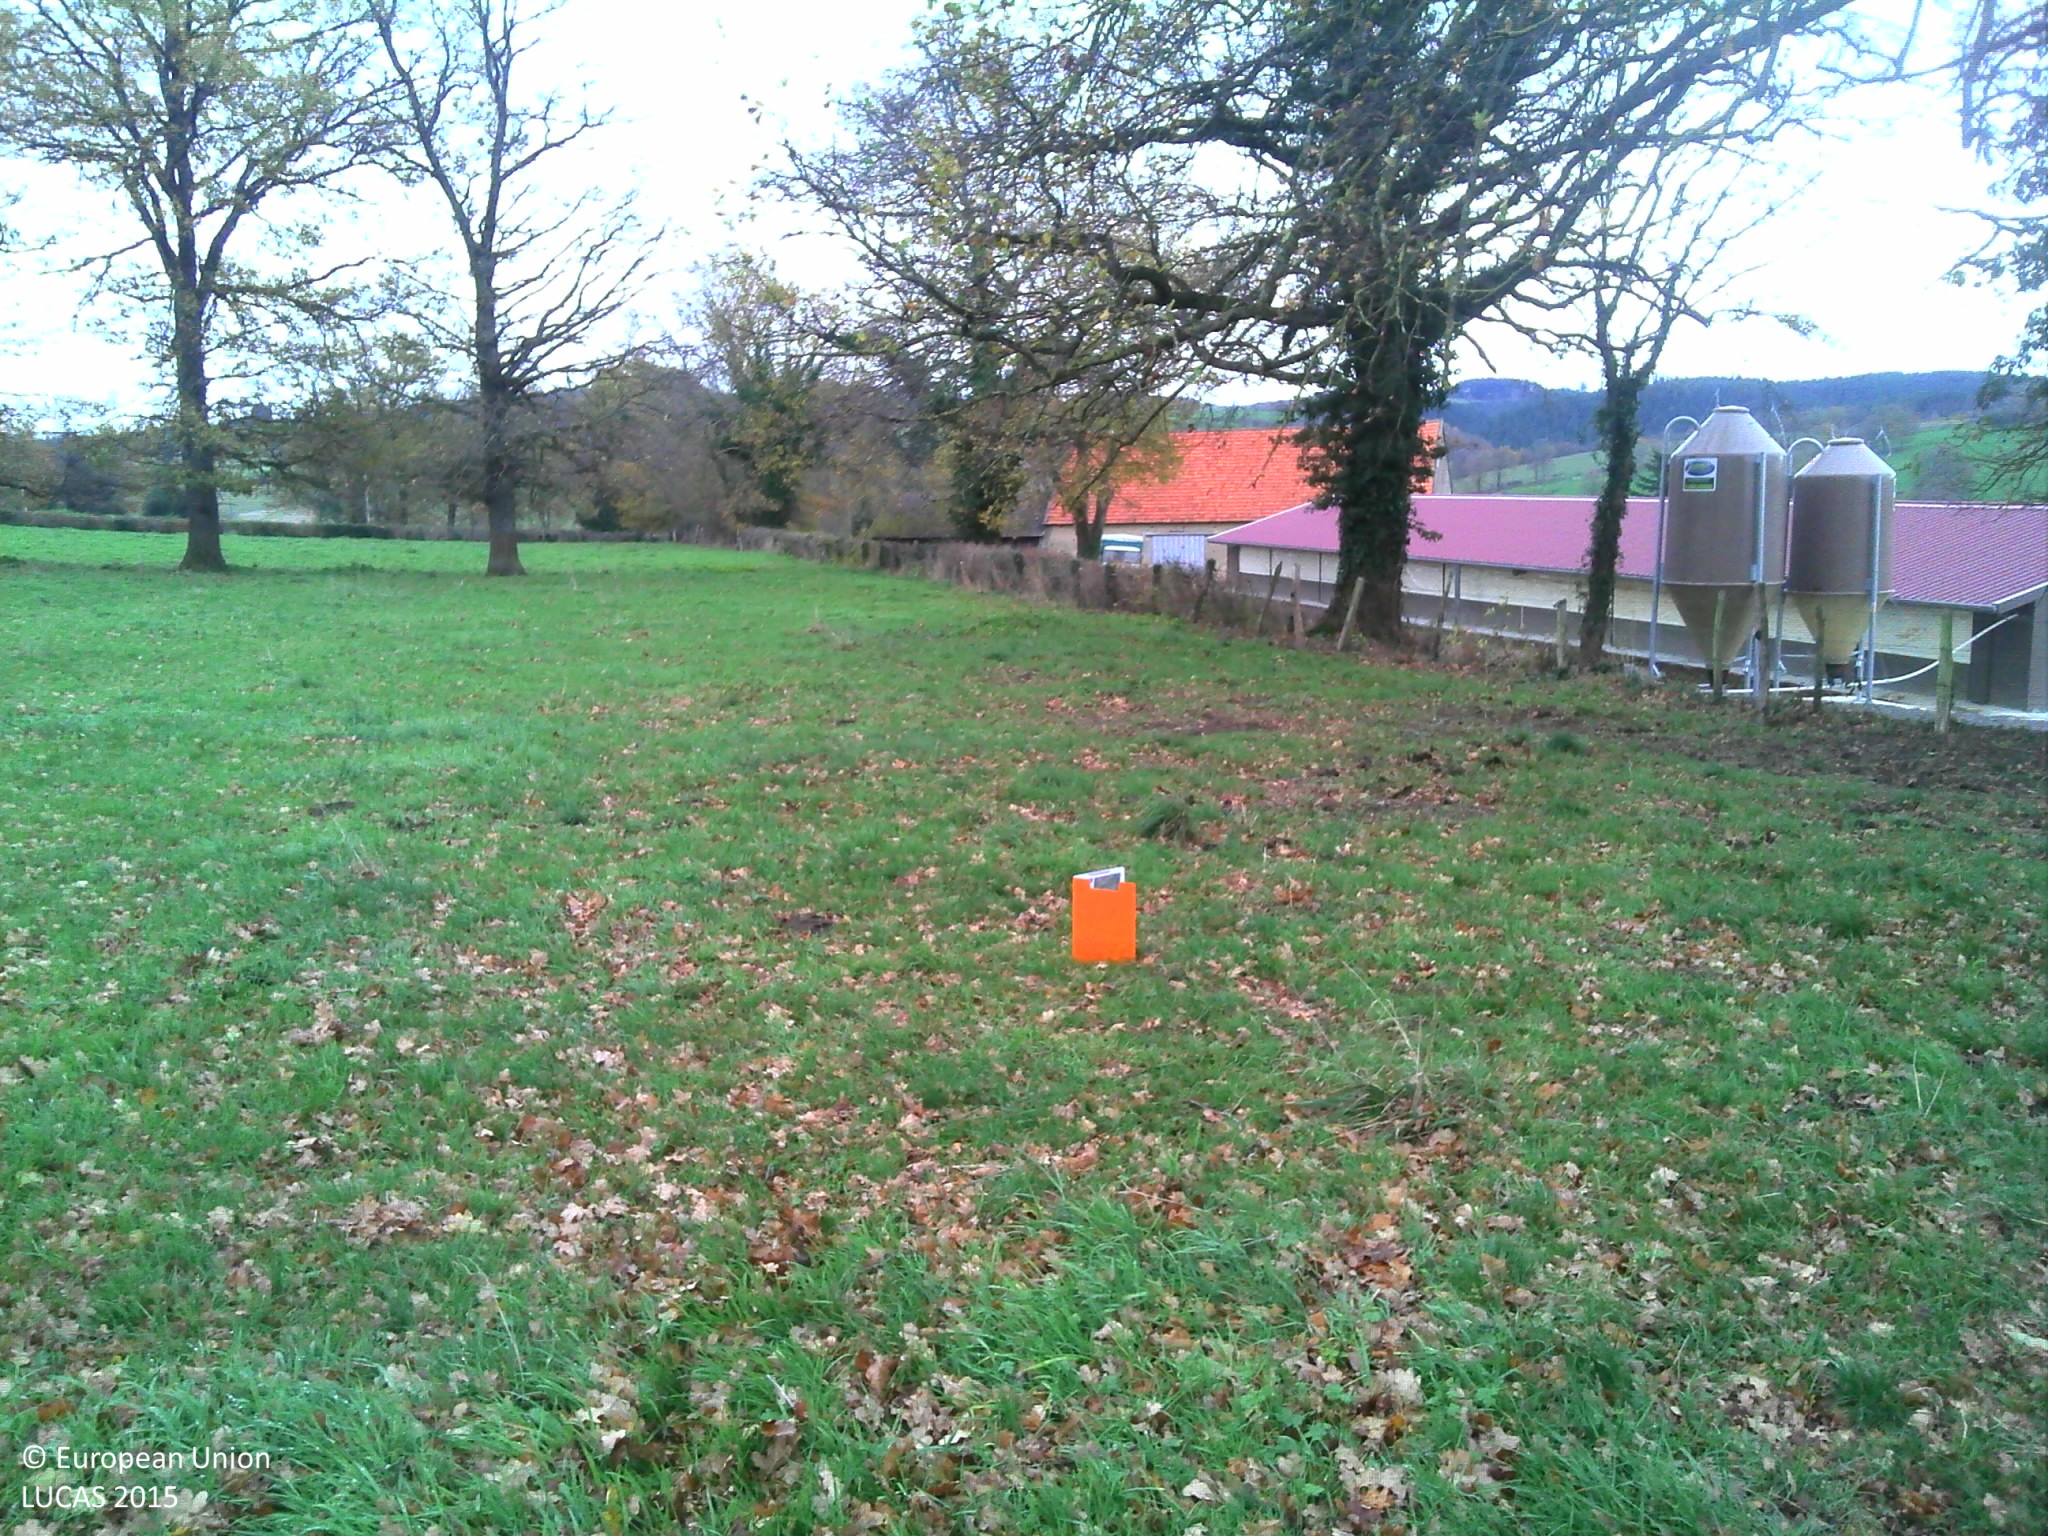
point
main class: Grassland
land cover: Grassland without tree/shrub cover
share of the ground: > 75 %
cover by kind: herbaceous plants 100 %
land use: Agriculture (excluding fallow land and kitchen gardens)
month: November
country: FR
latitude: 46.3280
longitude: 3.7001
